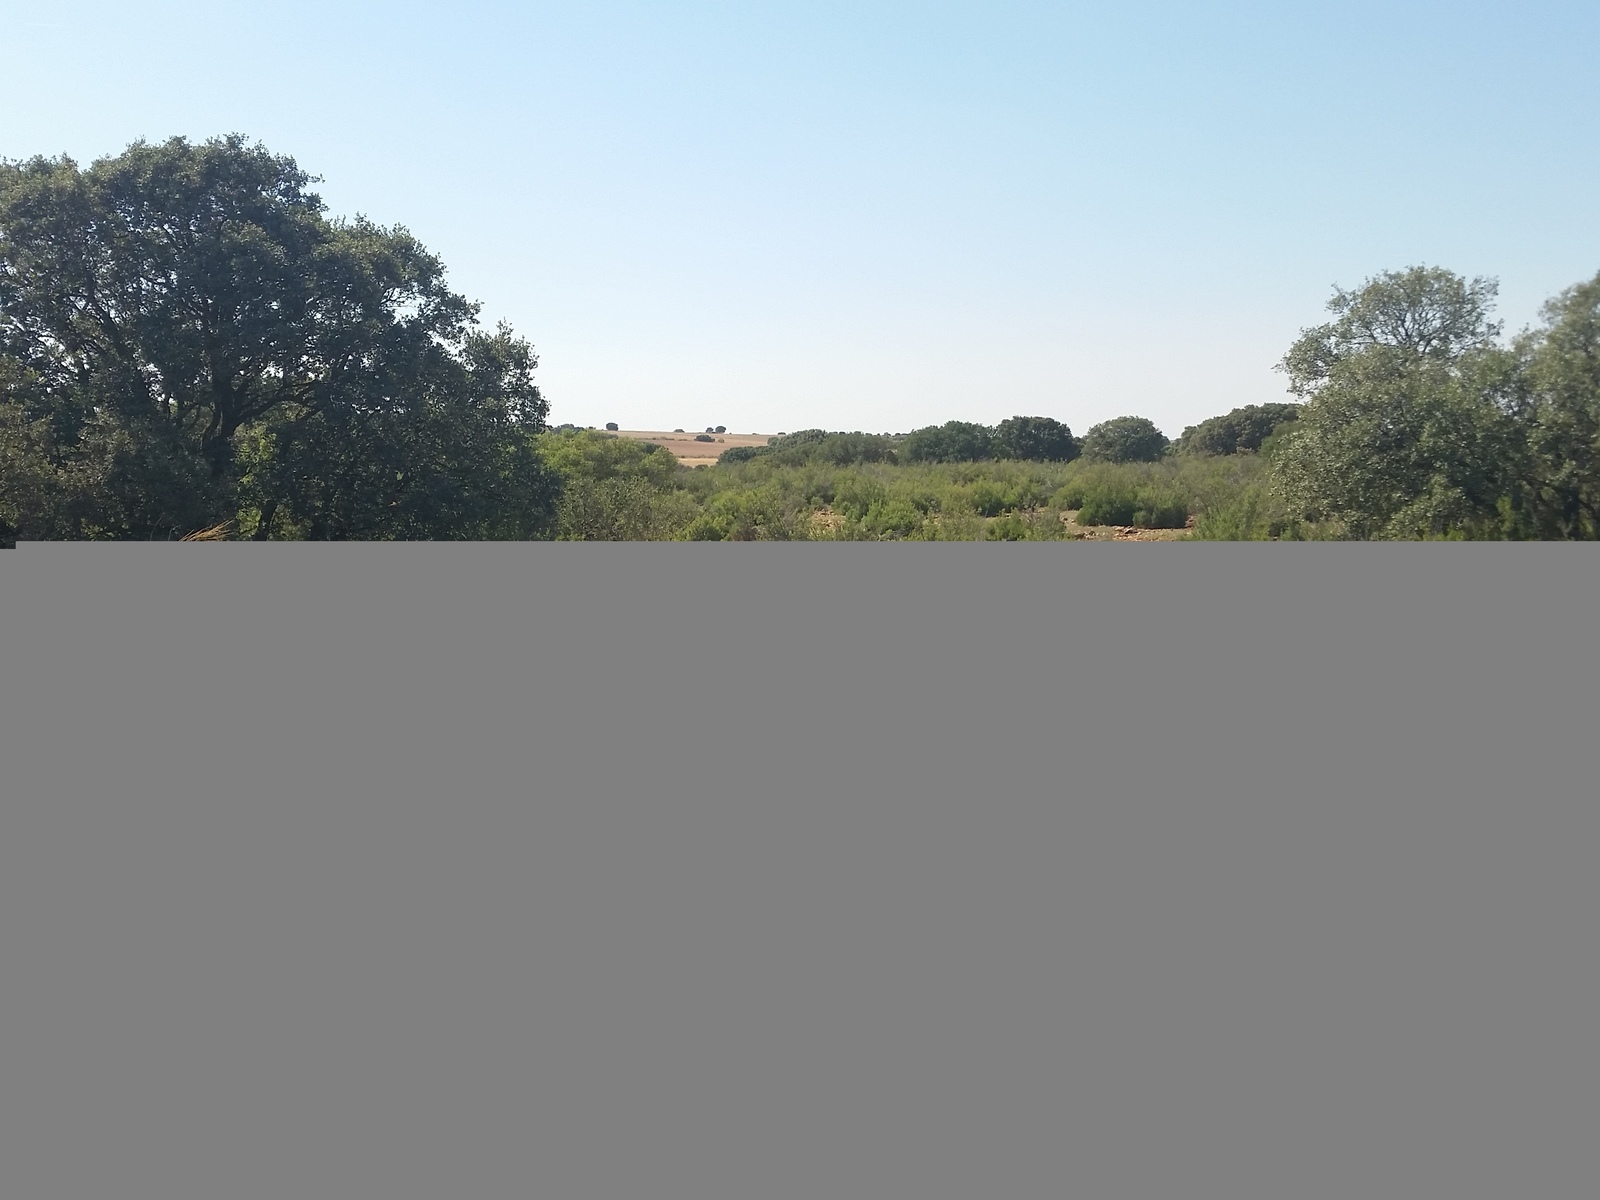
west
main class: Woodland
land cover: Broadleaved woodland
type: broadleaved evergreen forest
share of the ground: 50 - 75 %
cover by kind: broadleaved forest trees 50 %, shrubs 35 %, consolidated bare surface 10 %, herbaceous plants 5 %
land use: Semi-natural and natural areas not in use
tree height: < 5 m
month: July
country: ES
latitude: 39.0800
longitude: -2.5028
